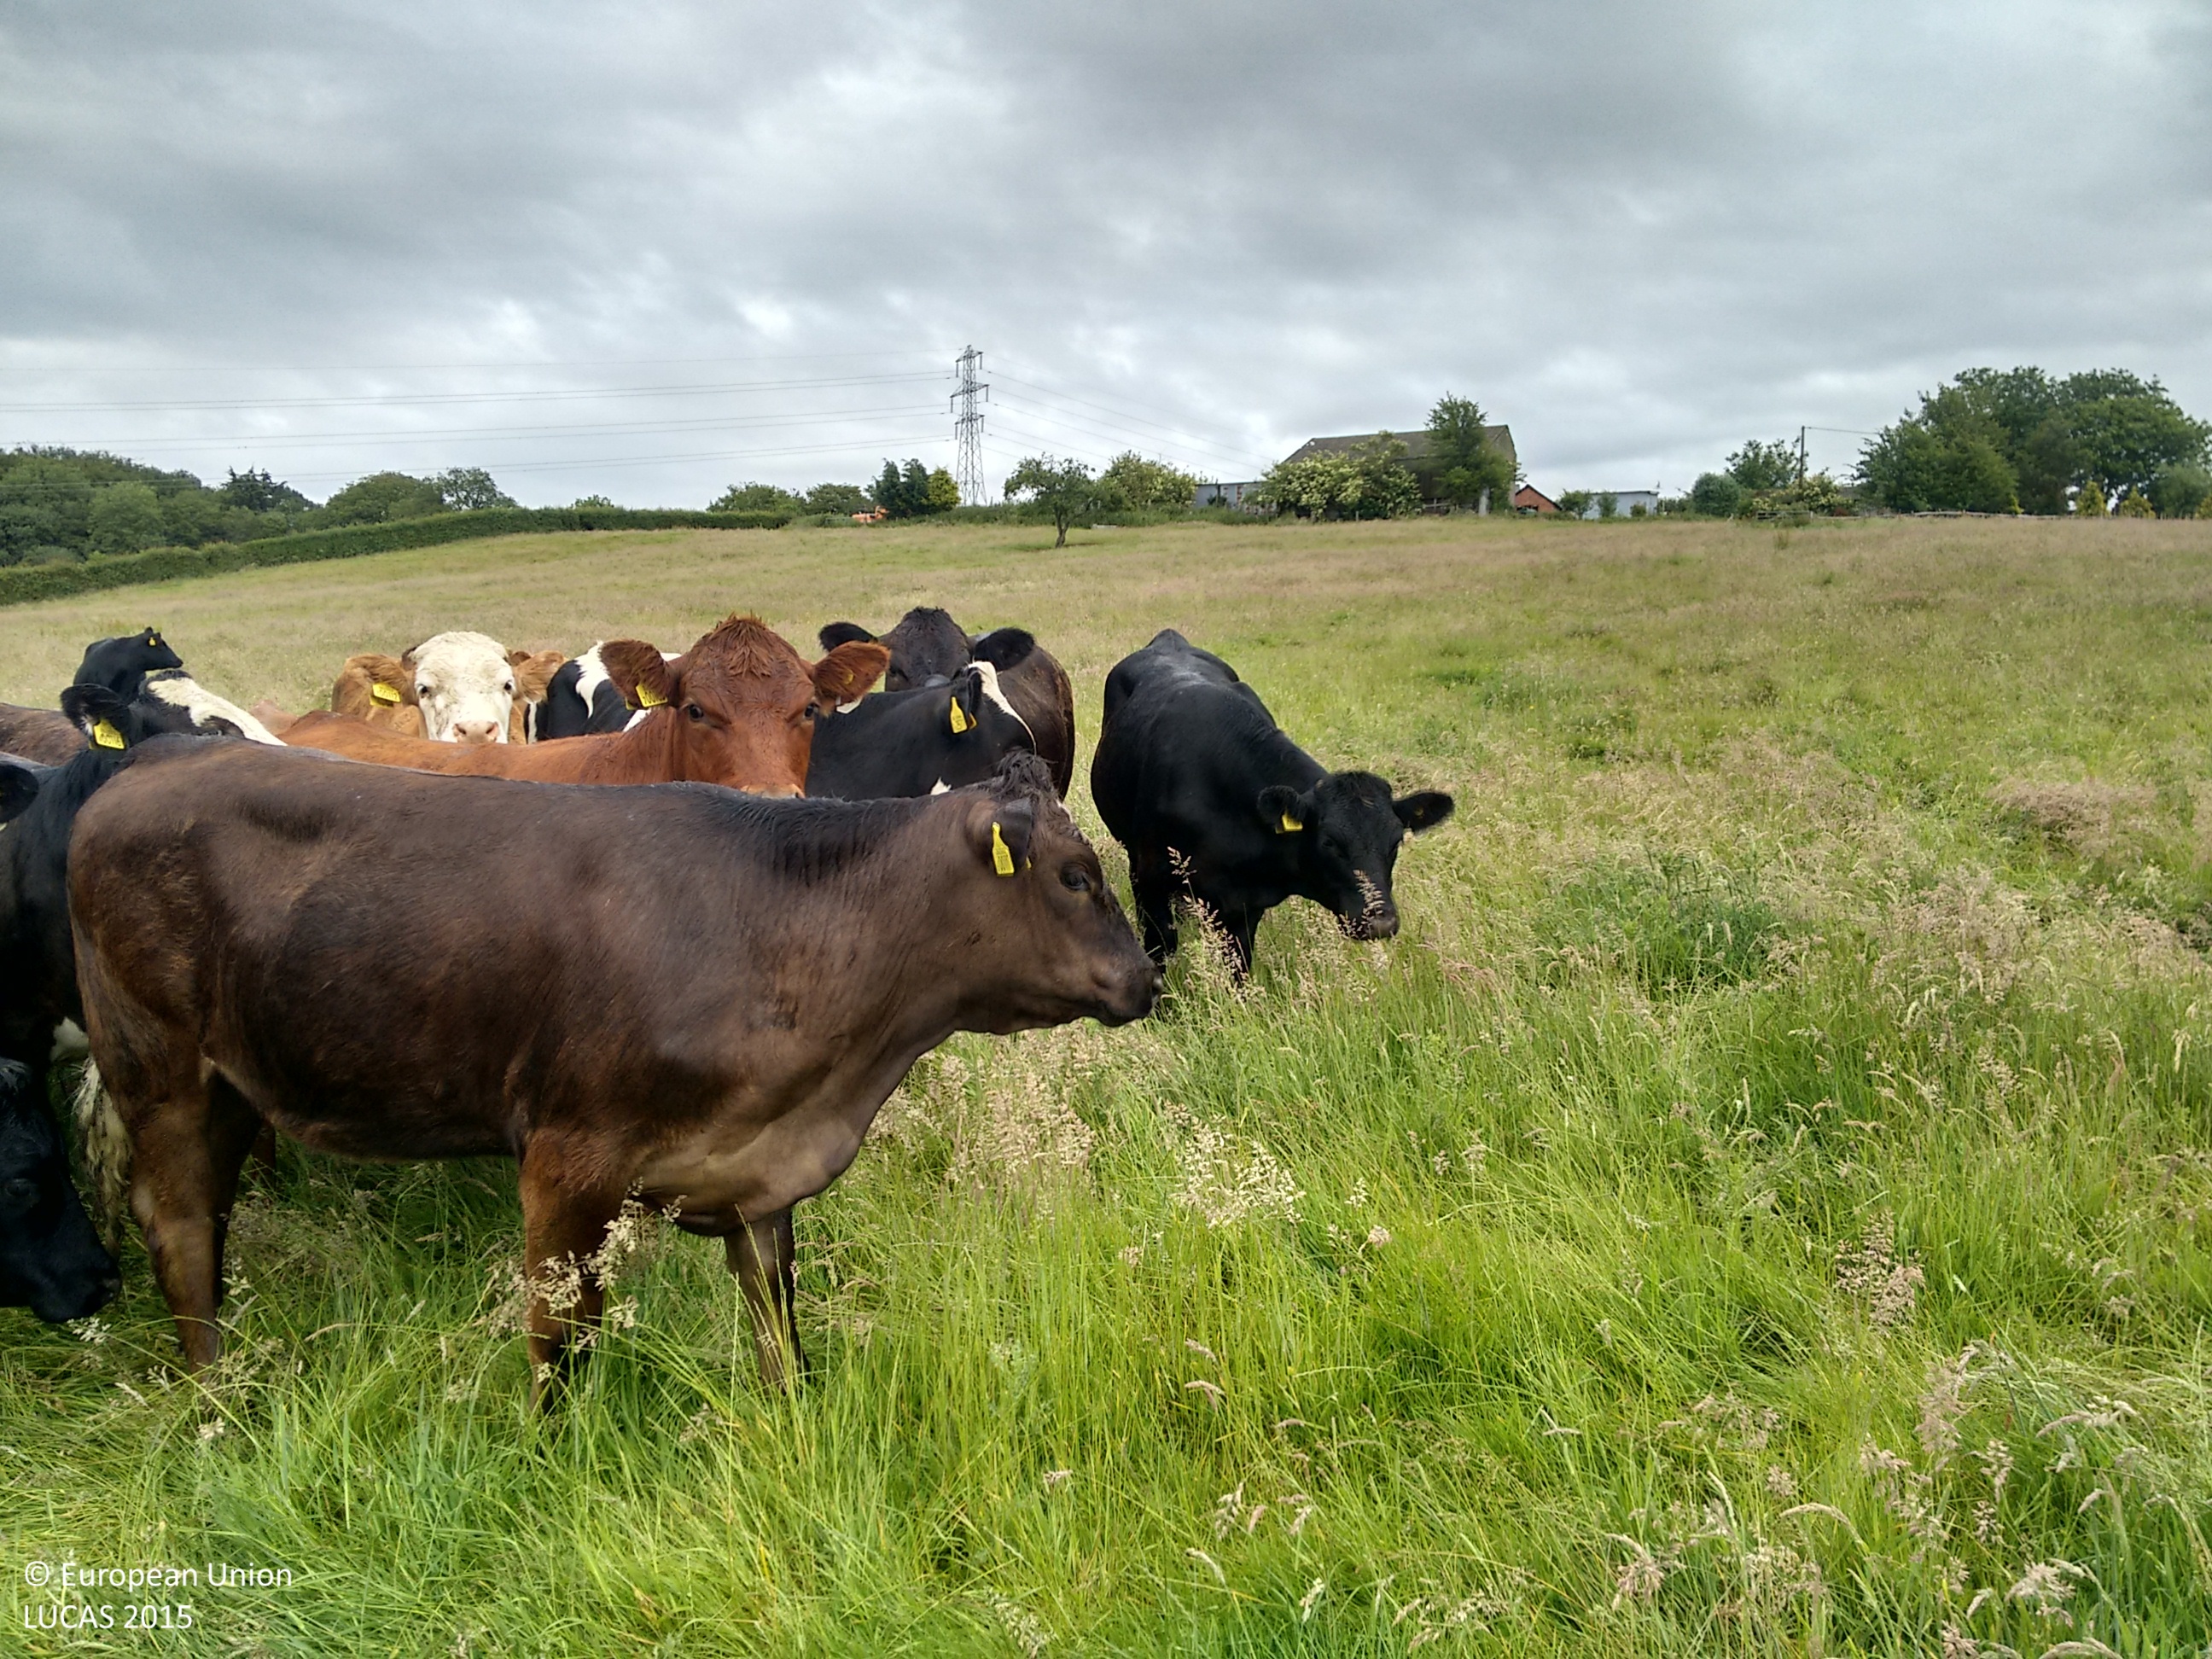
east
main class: Grassland
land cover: Grassland without tree/shrub cover
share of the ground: > 75 %
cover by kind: herbaceous plants 100 %
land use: Agriculture (excluding fallow land and kitchen gardens)
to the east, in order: Grassland without tree/shrub cover; Artificial constructions in urban areas; Managed hedges; Grass margins; Paved roads, cycling and walking lanes; Grass margins; Managed hedges; Common wheat
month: June
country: GB
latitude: 50.9273
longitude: 0.2812
